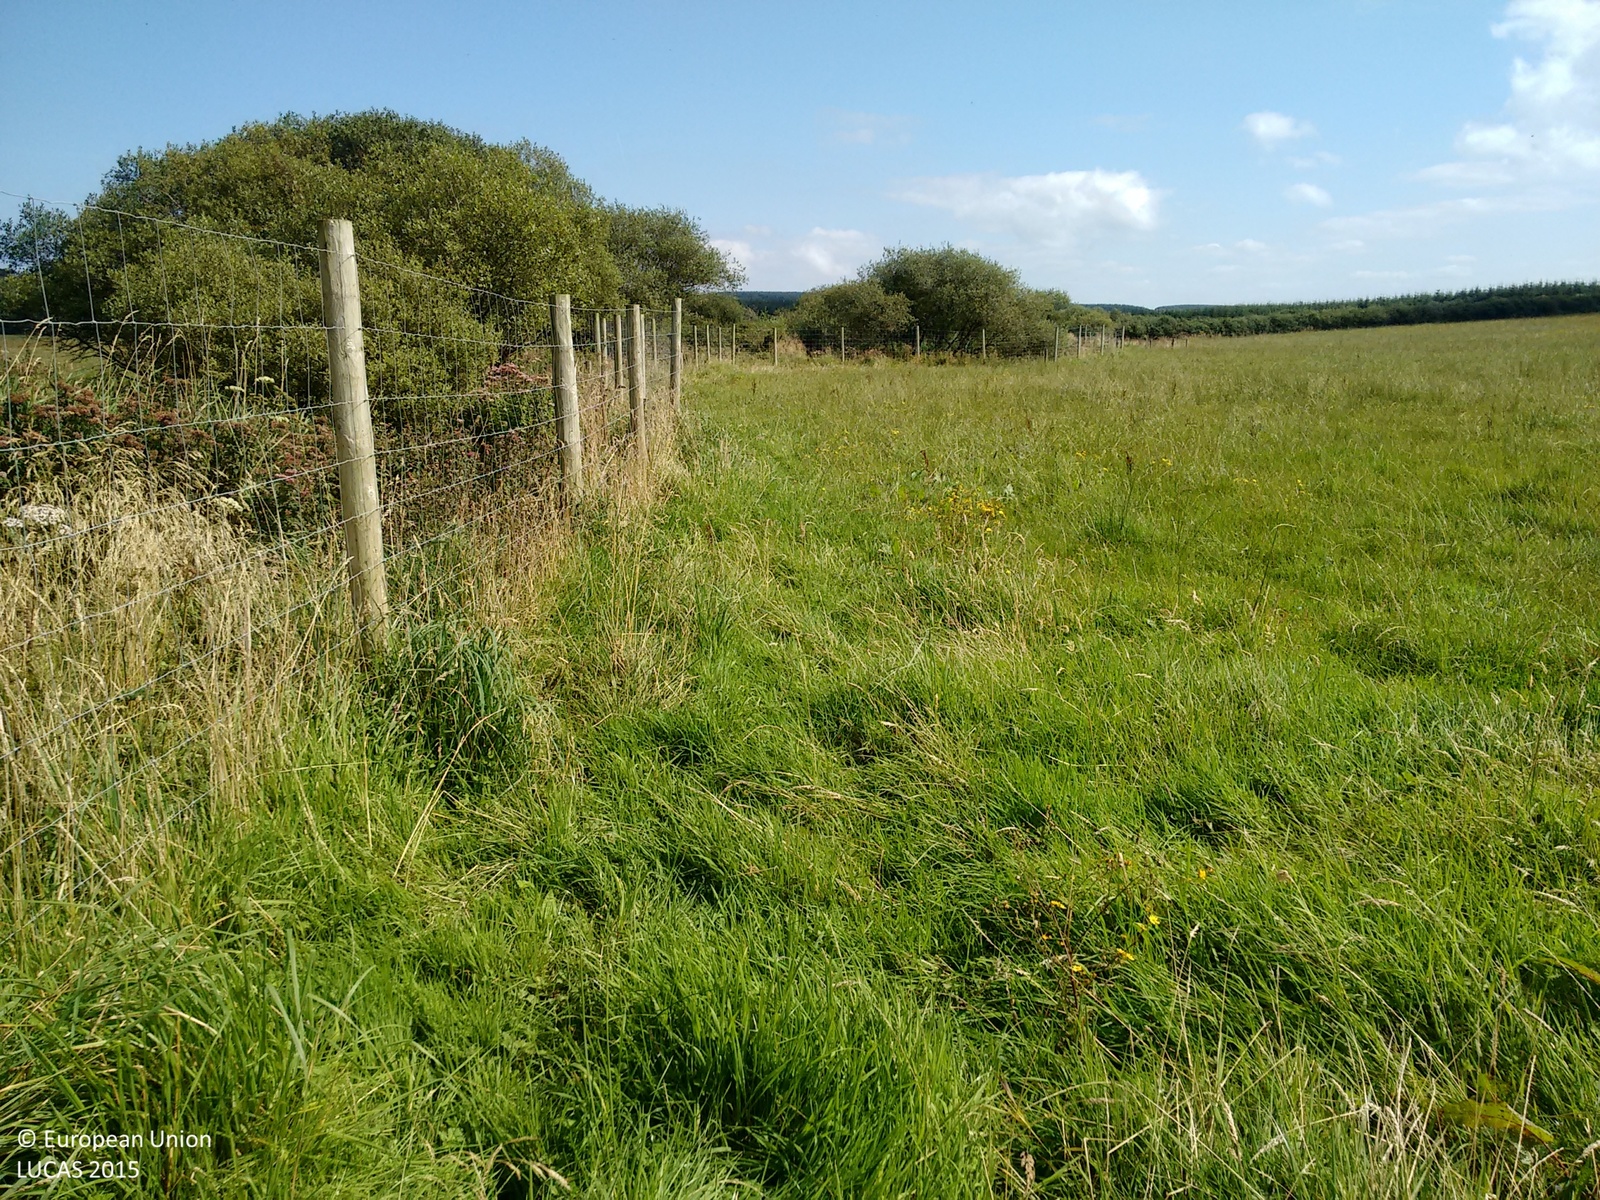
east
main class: Woodland
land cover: Broadleaved woodland
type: mesophytic deciduous forest
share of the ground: > 75 %
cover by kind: broadleaved forest trees 100 %
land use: Semi-natural and natural areas not in use
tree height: > 5 m
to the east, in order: Broadleaved woodland; Rivers and streams; Fences; Electric lines; Grassland without tree/shrub cover; Fences; Abandoned hedges
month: September
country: GB
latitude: 50.9582
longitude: -4.4402
